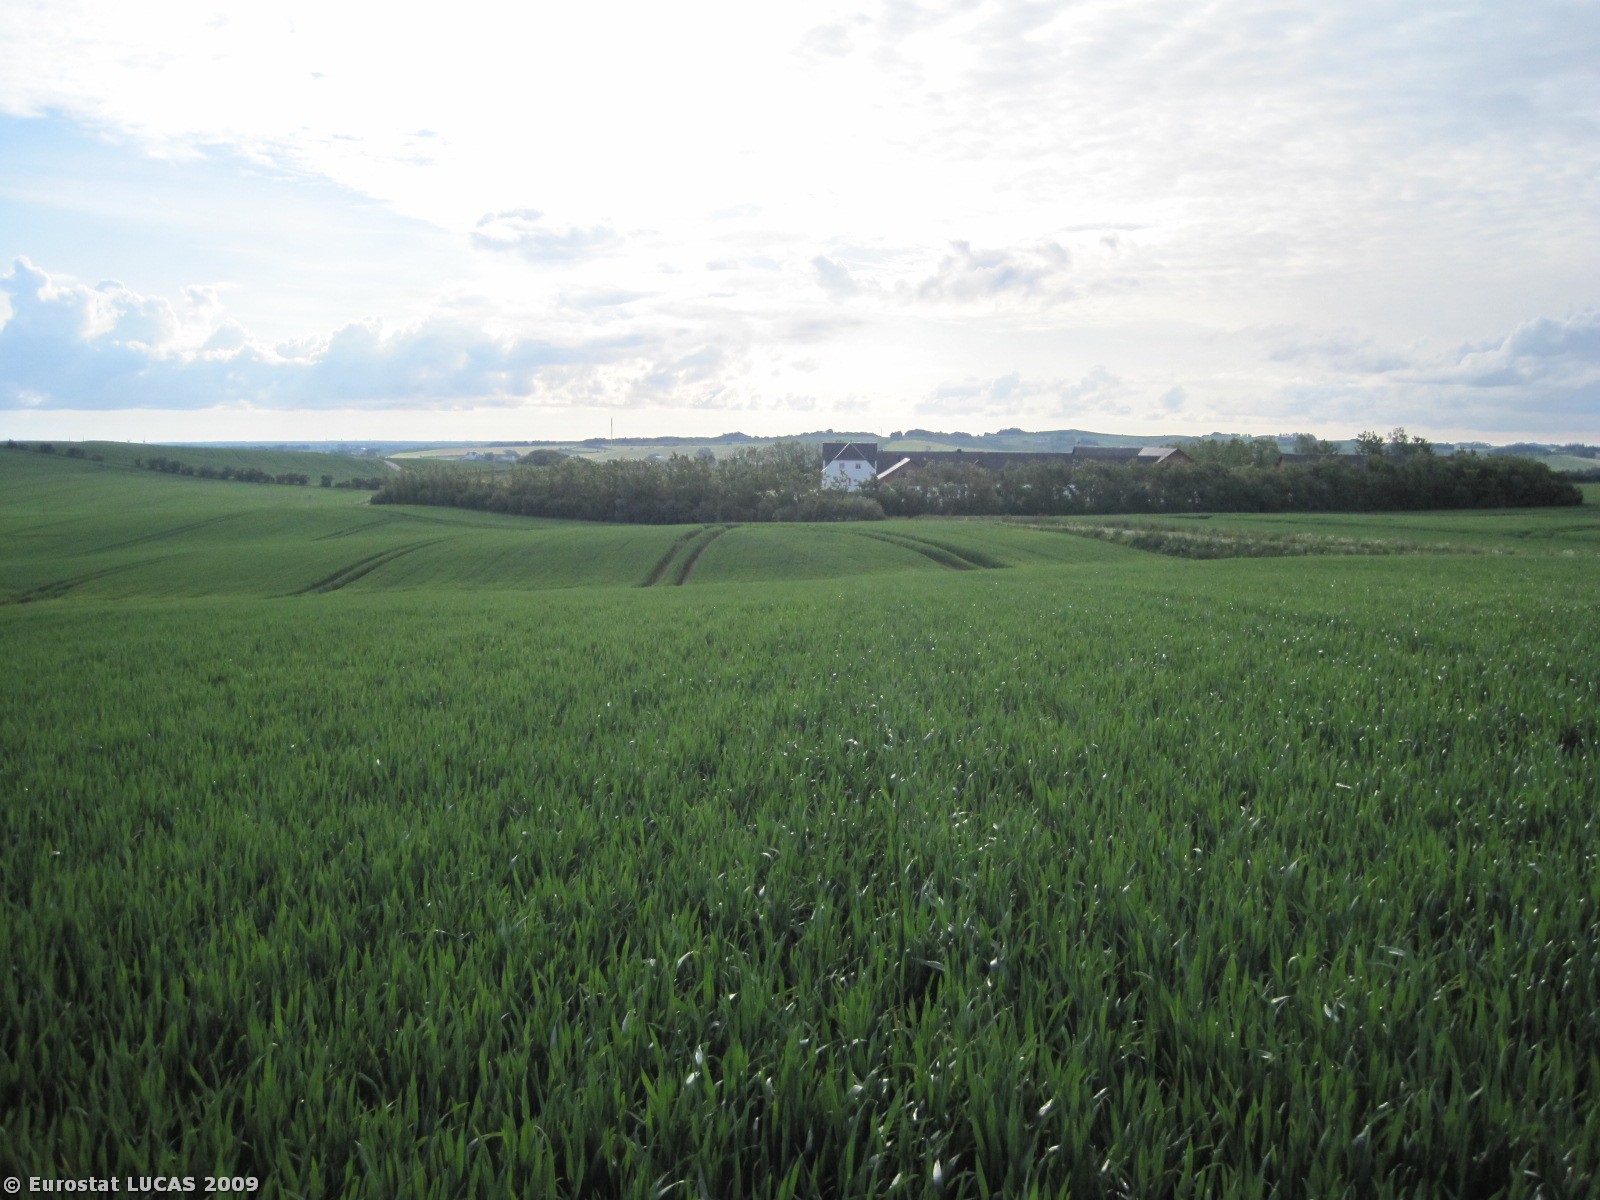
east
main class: Cropland
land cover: Common wheat
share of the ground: > 75 %
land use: Agriculture (excluding fallow land and kitchen gardens)
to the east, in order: Common wheat; Grass margins; Paved roads, cycling and walking lanes; Grassland without tree/shrub cover; Common wheat; Broadleaved woodland; Tracks; Broadleaved woodland; Artificial constructions in urban areas
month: June
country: DK
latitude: 57.5361
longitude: 9.9833
